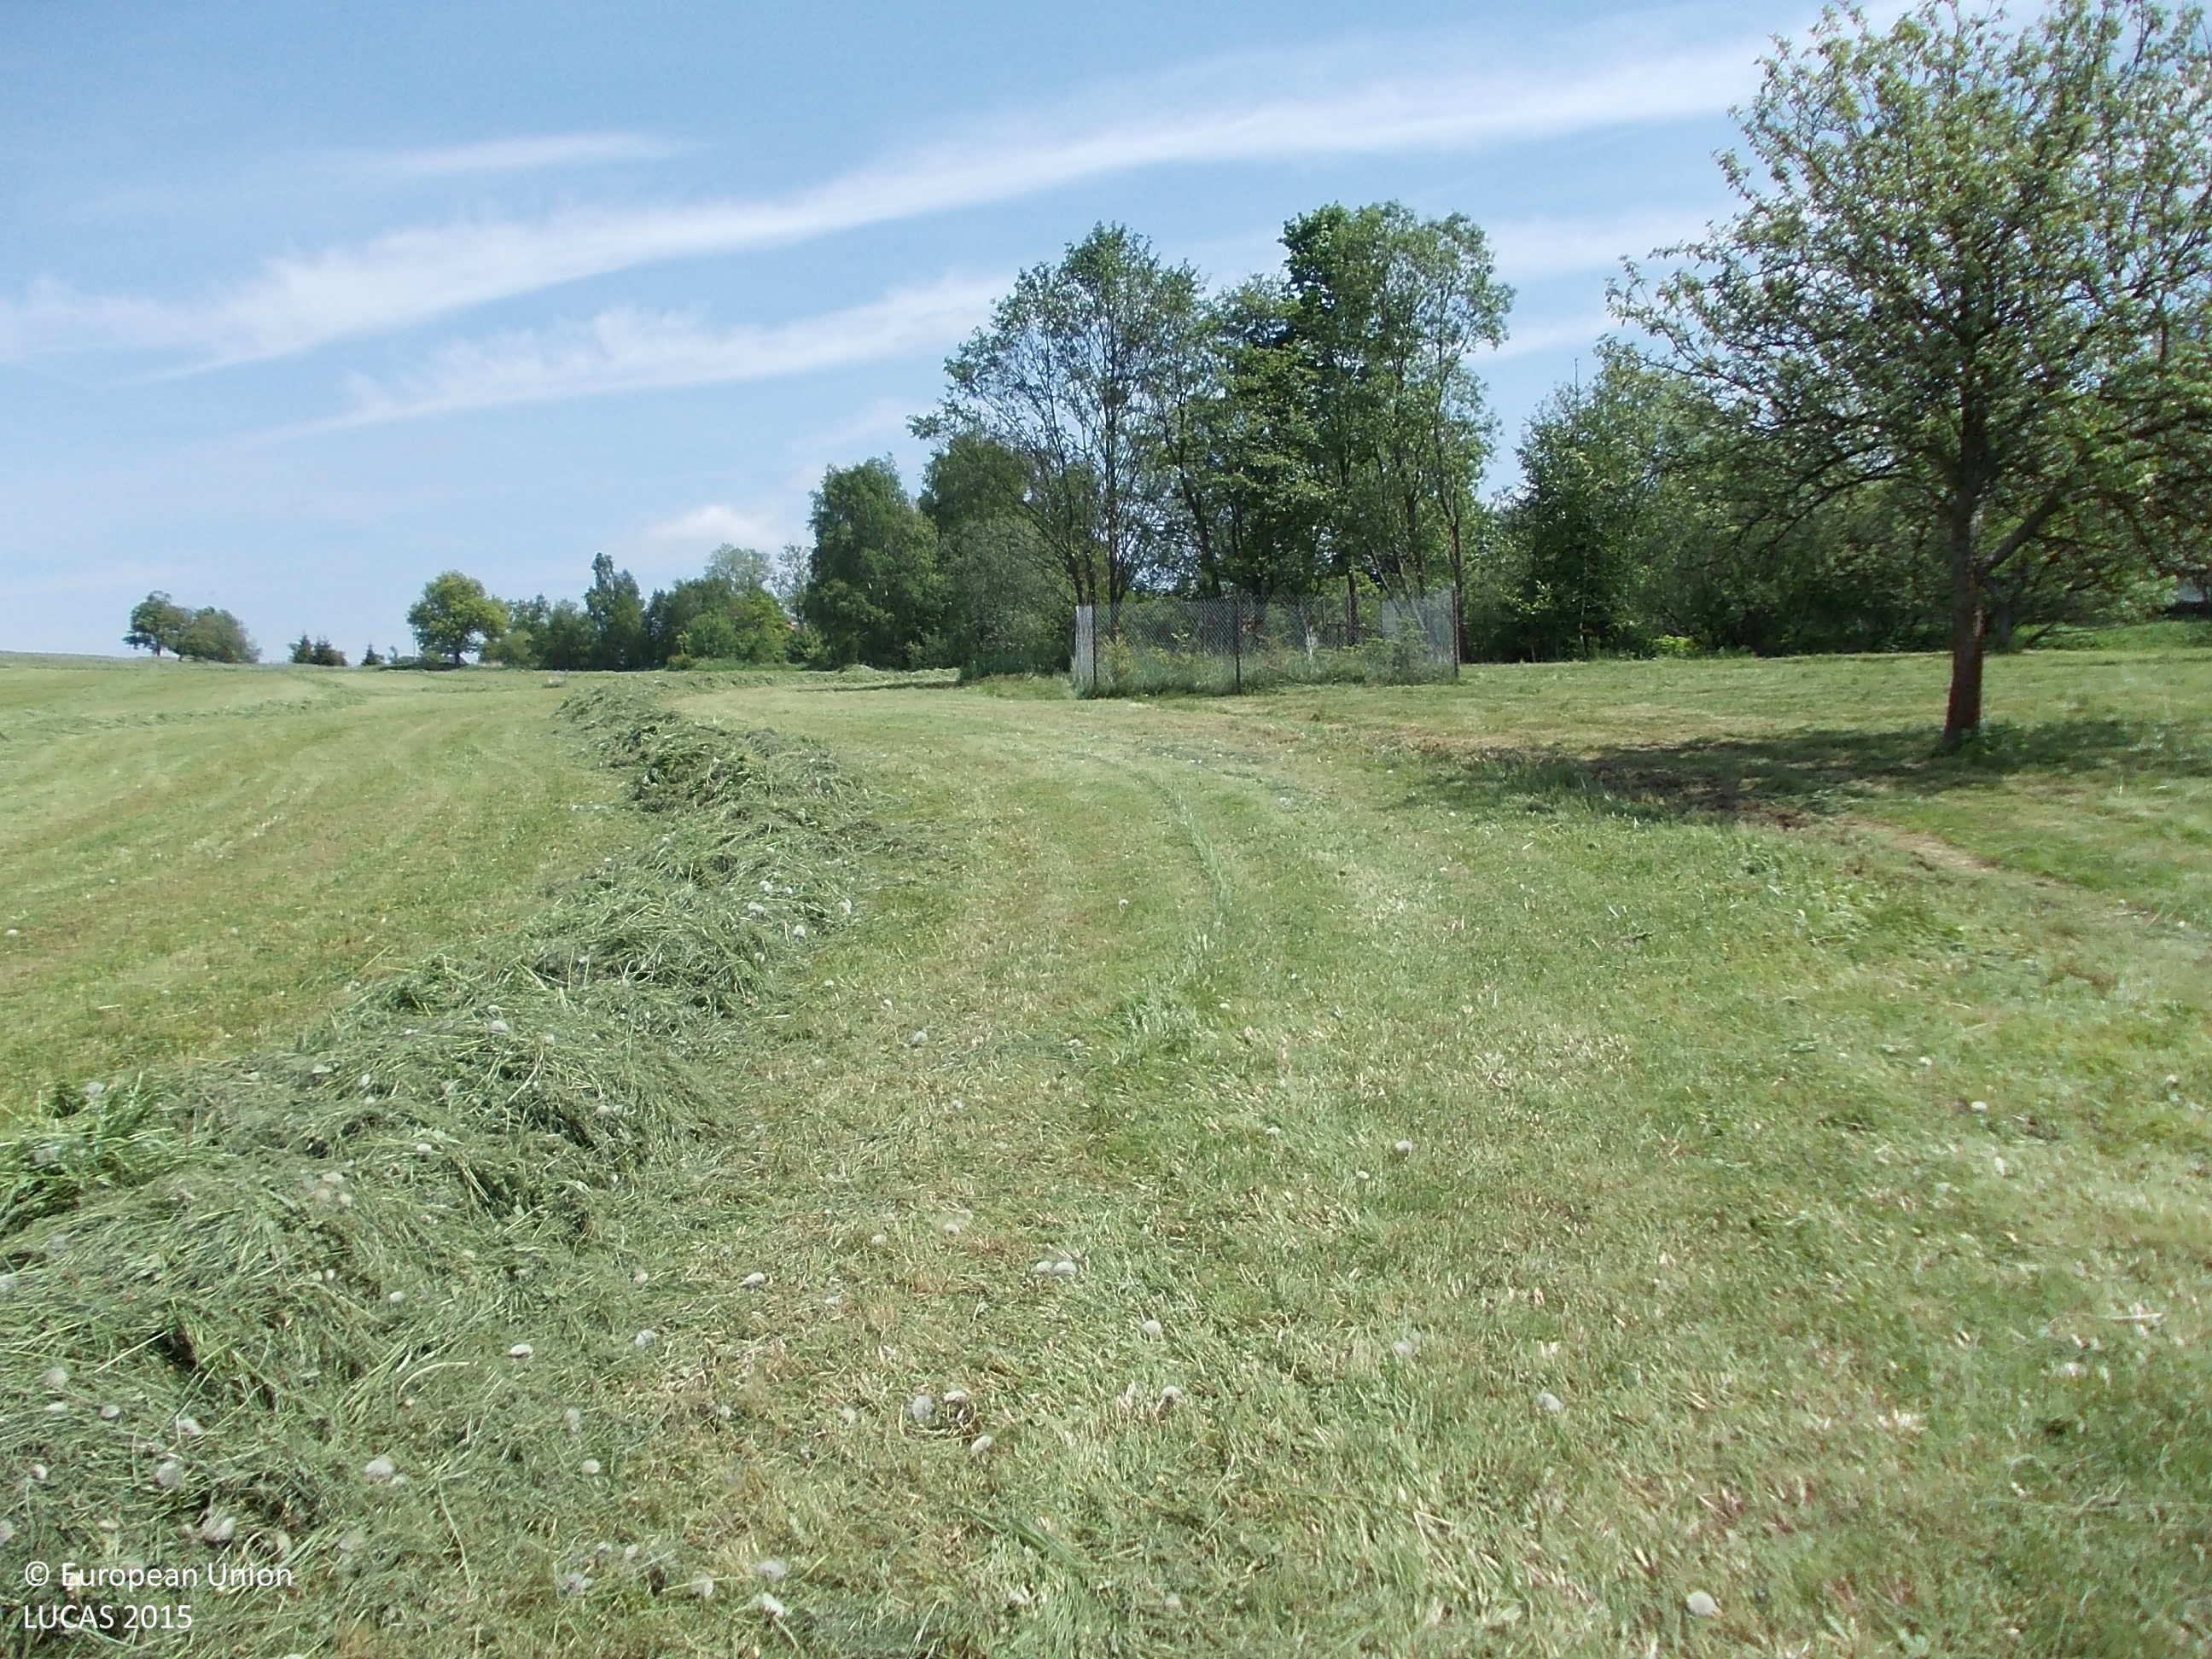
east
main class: Grassland
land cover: Grassland without tree/shrub cover
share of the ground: > 75 %
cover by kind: herbaceous plants 100 %
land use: Agriculture (excluding fallow land and kitchen gardens)
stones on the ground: < 10 %
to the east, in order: Grassland without tree/shrub cover; Broadleaved woodland; Grassland without tree/shrub cover; Broadleaved woodland; Artificial constructions in urban areas; Grassland with sparse tree/shrub cover; Grassland without tree/shrub cover
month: May
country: CZ
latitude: 49.1335
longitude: 13.7144
